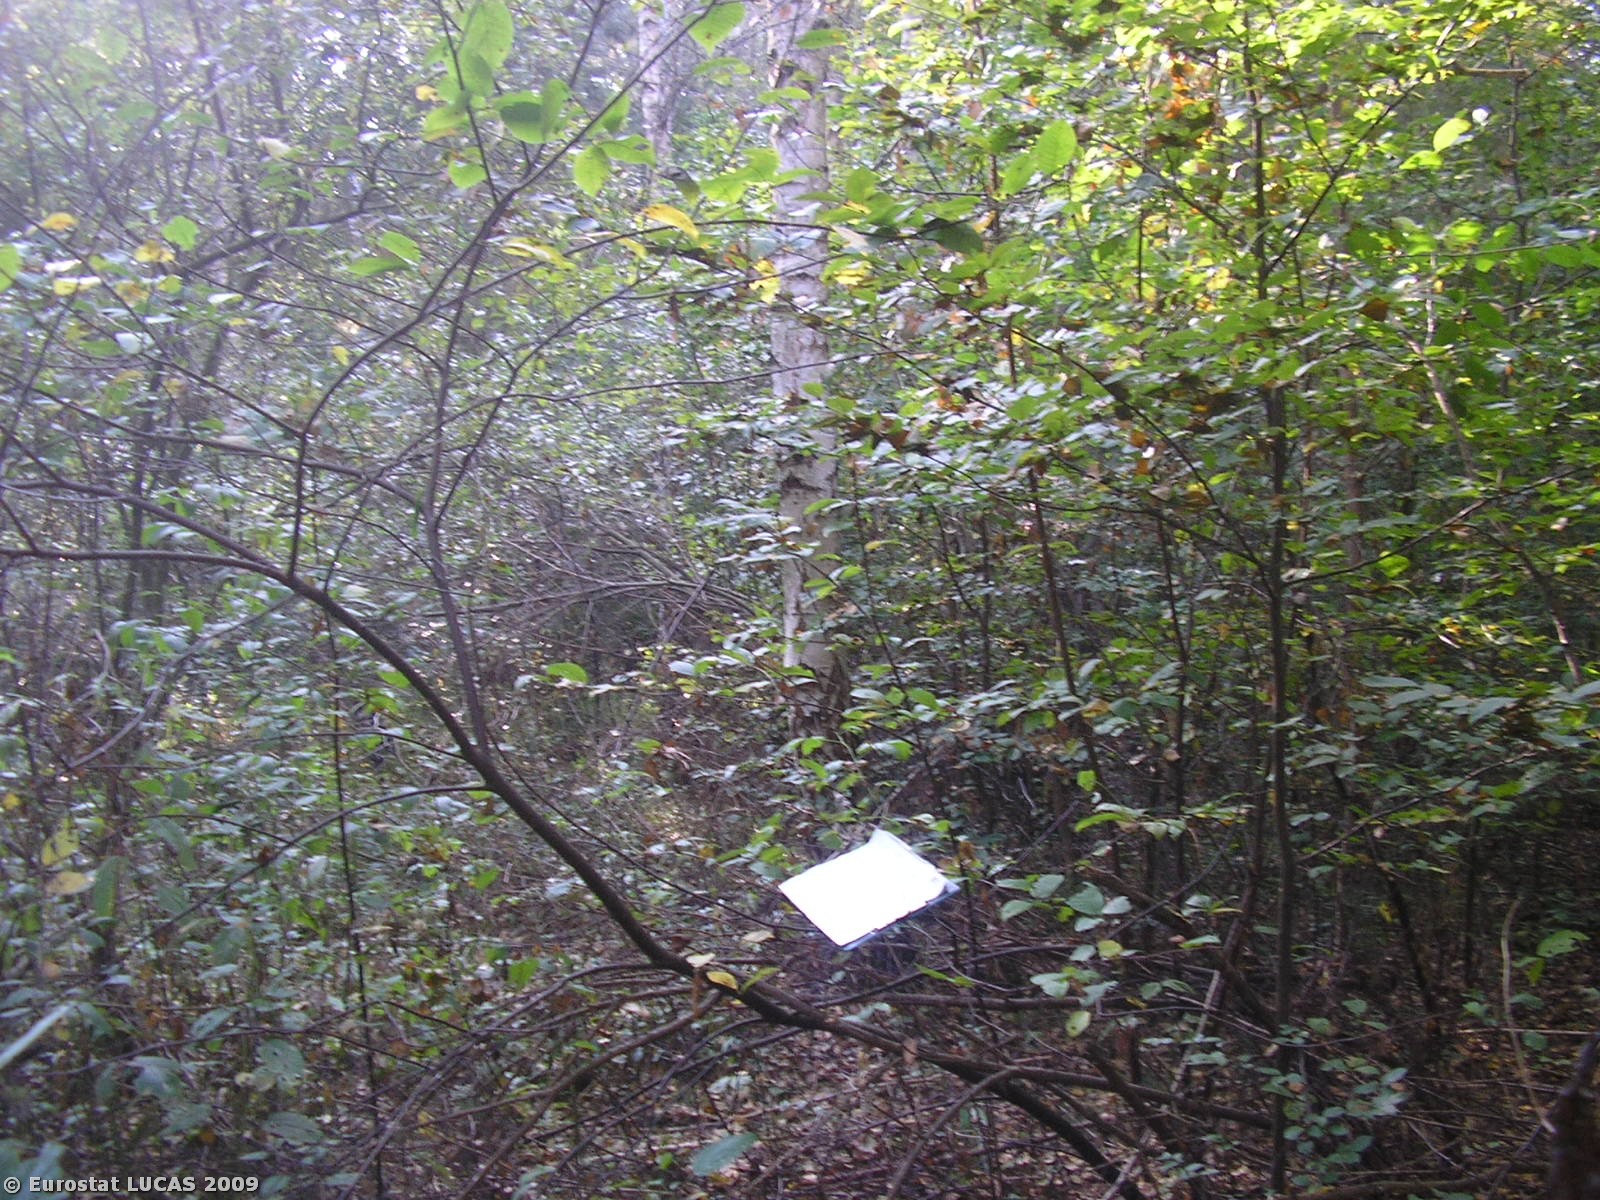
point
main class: Woodland
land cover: Broadleaved woodland
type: non-riverine alder, birch or aspen forest
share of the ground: > 75 %
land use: Forestry
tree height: > 5 m
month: September
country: PL
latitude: 51.9845
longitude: 20.6844
